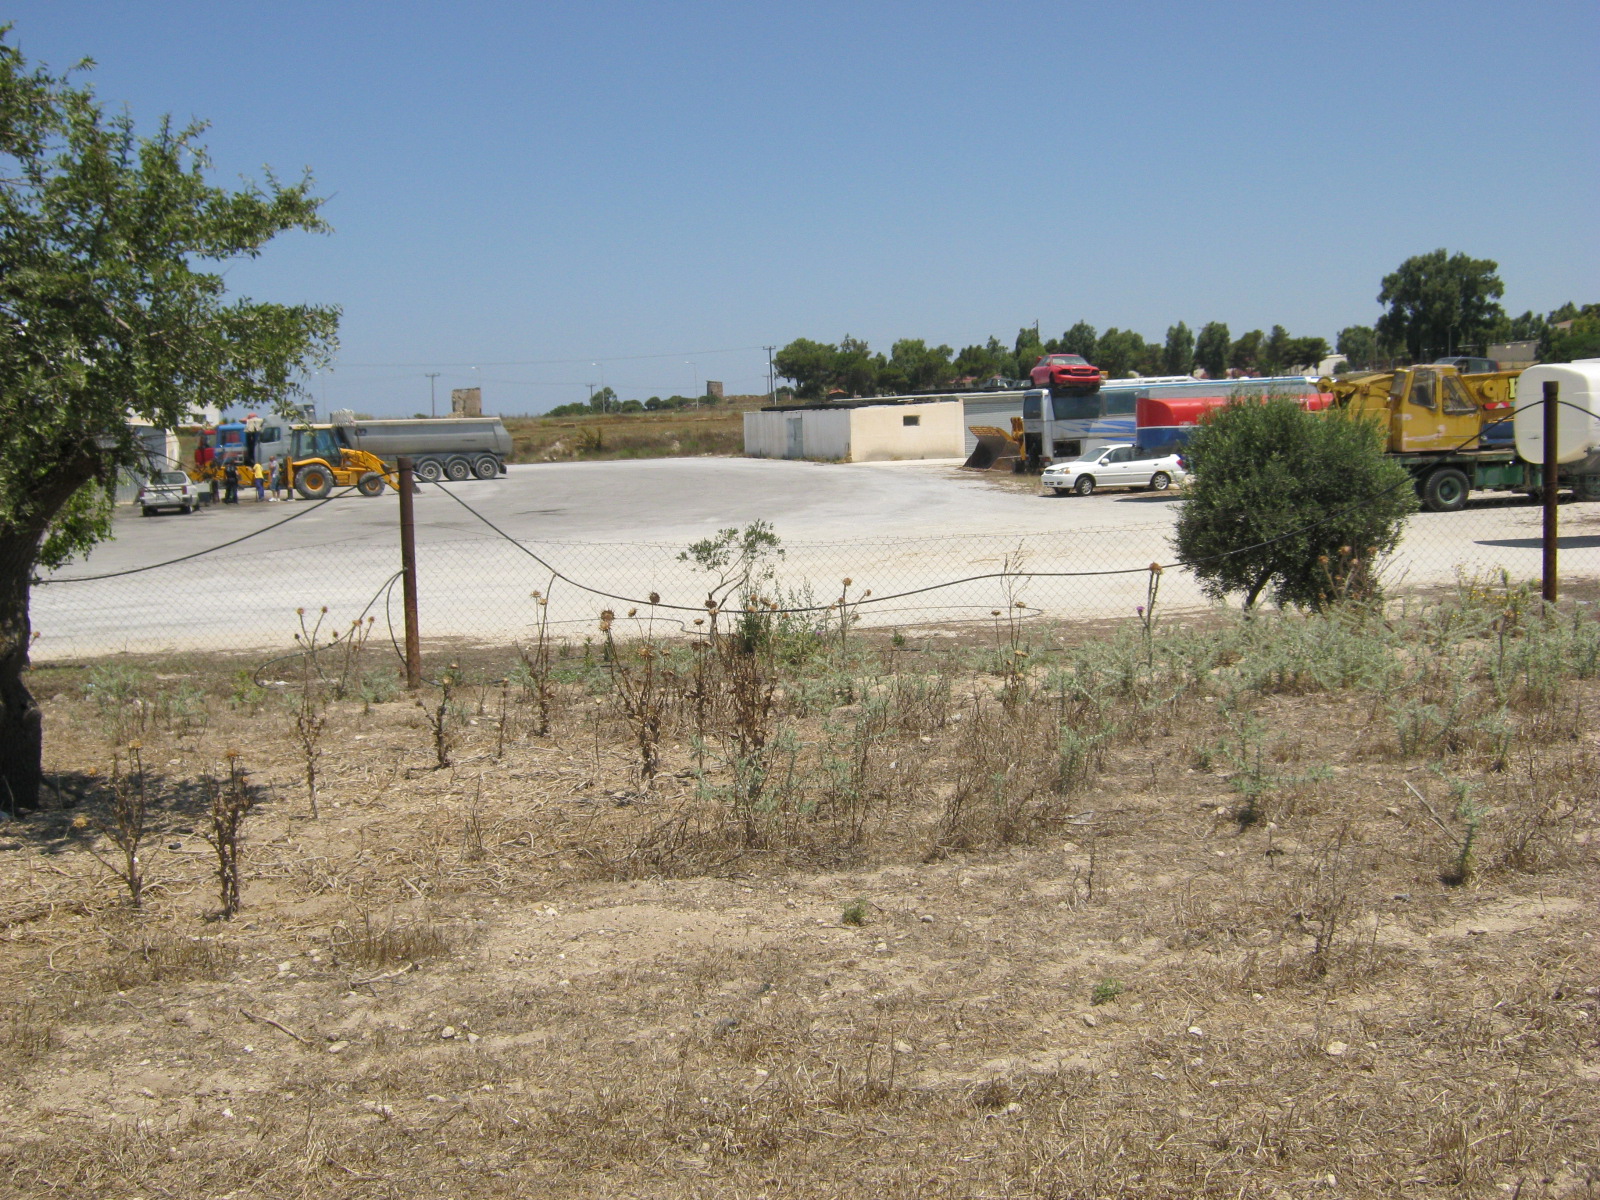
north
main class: Grassland
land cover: Grassland without tree/shrub cover
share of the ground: 50 - 75 %
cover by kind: herbaceous plants 70 %, consolidated bare surface 30 %
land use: Agriculture (excluding fallow land and kitchen gardens)
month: June
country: GR
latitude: 36.8139
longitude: 27.1044
